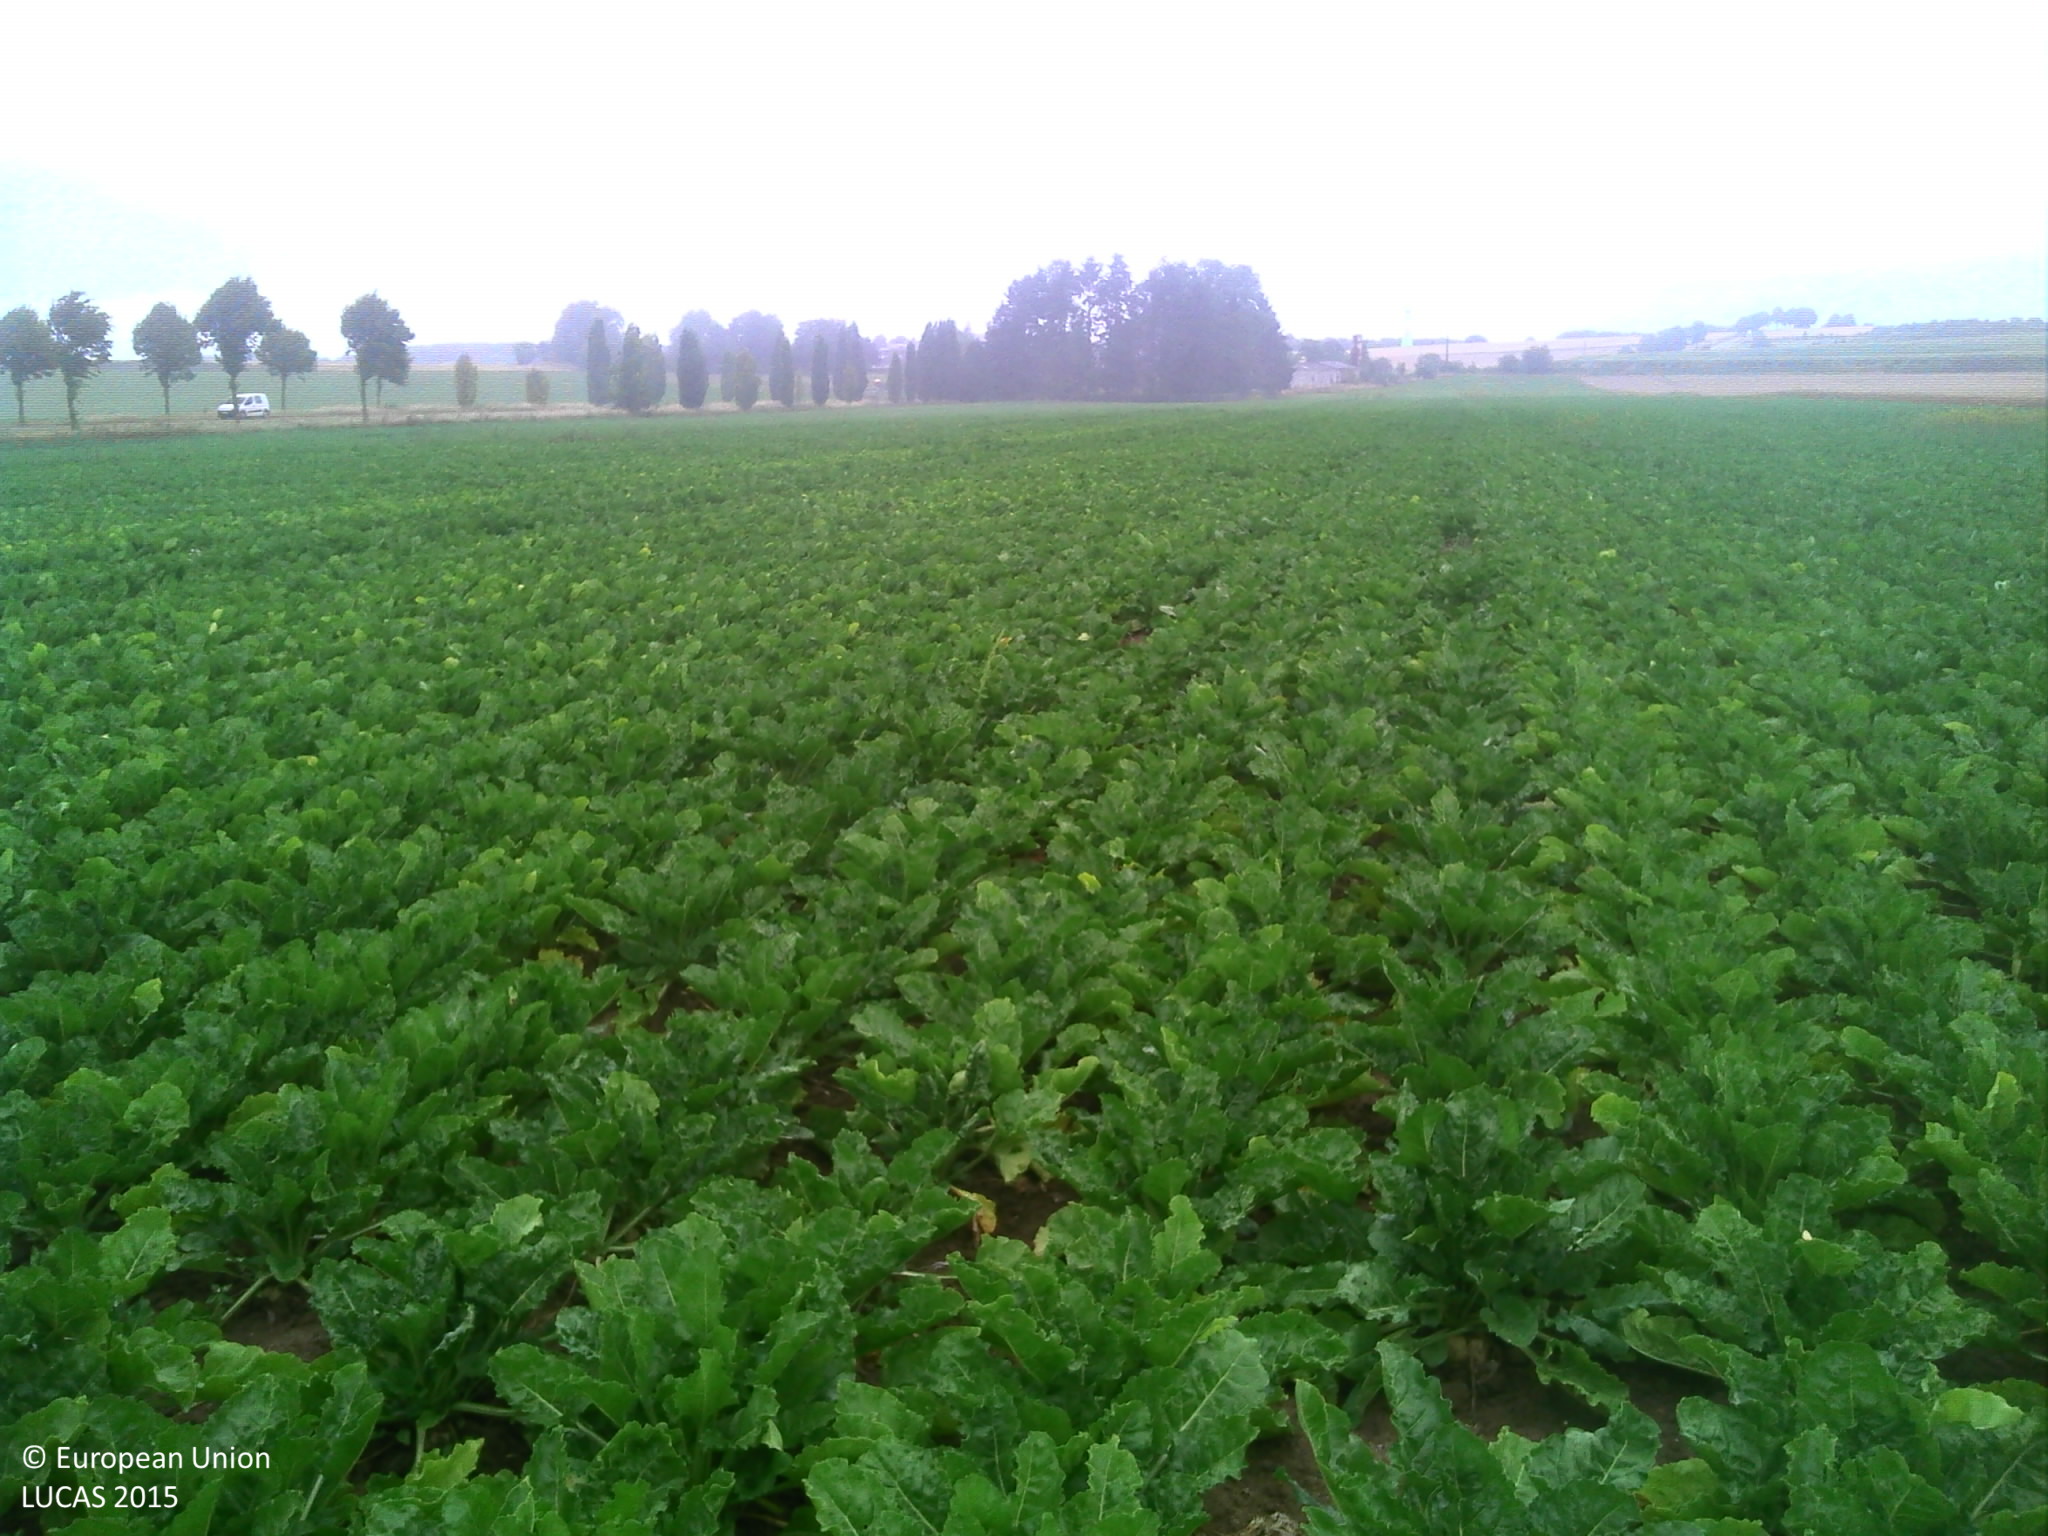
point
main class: Cropland
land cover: Sugar beet
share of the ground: > 75 %
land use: Agriculture (excluding fallow land and kitchen gardens)
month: July
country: FR
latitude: 49.9158
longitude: 3.6285
